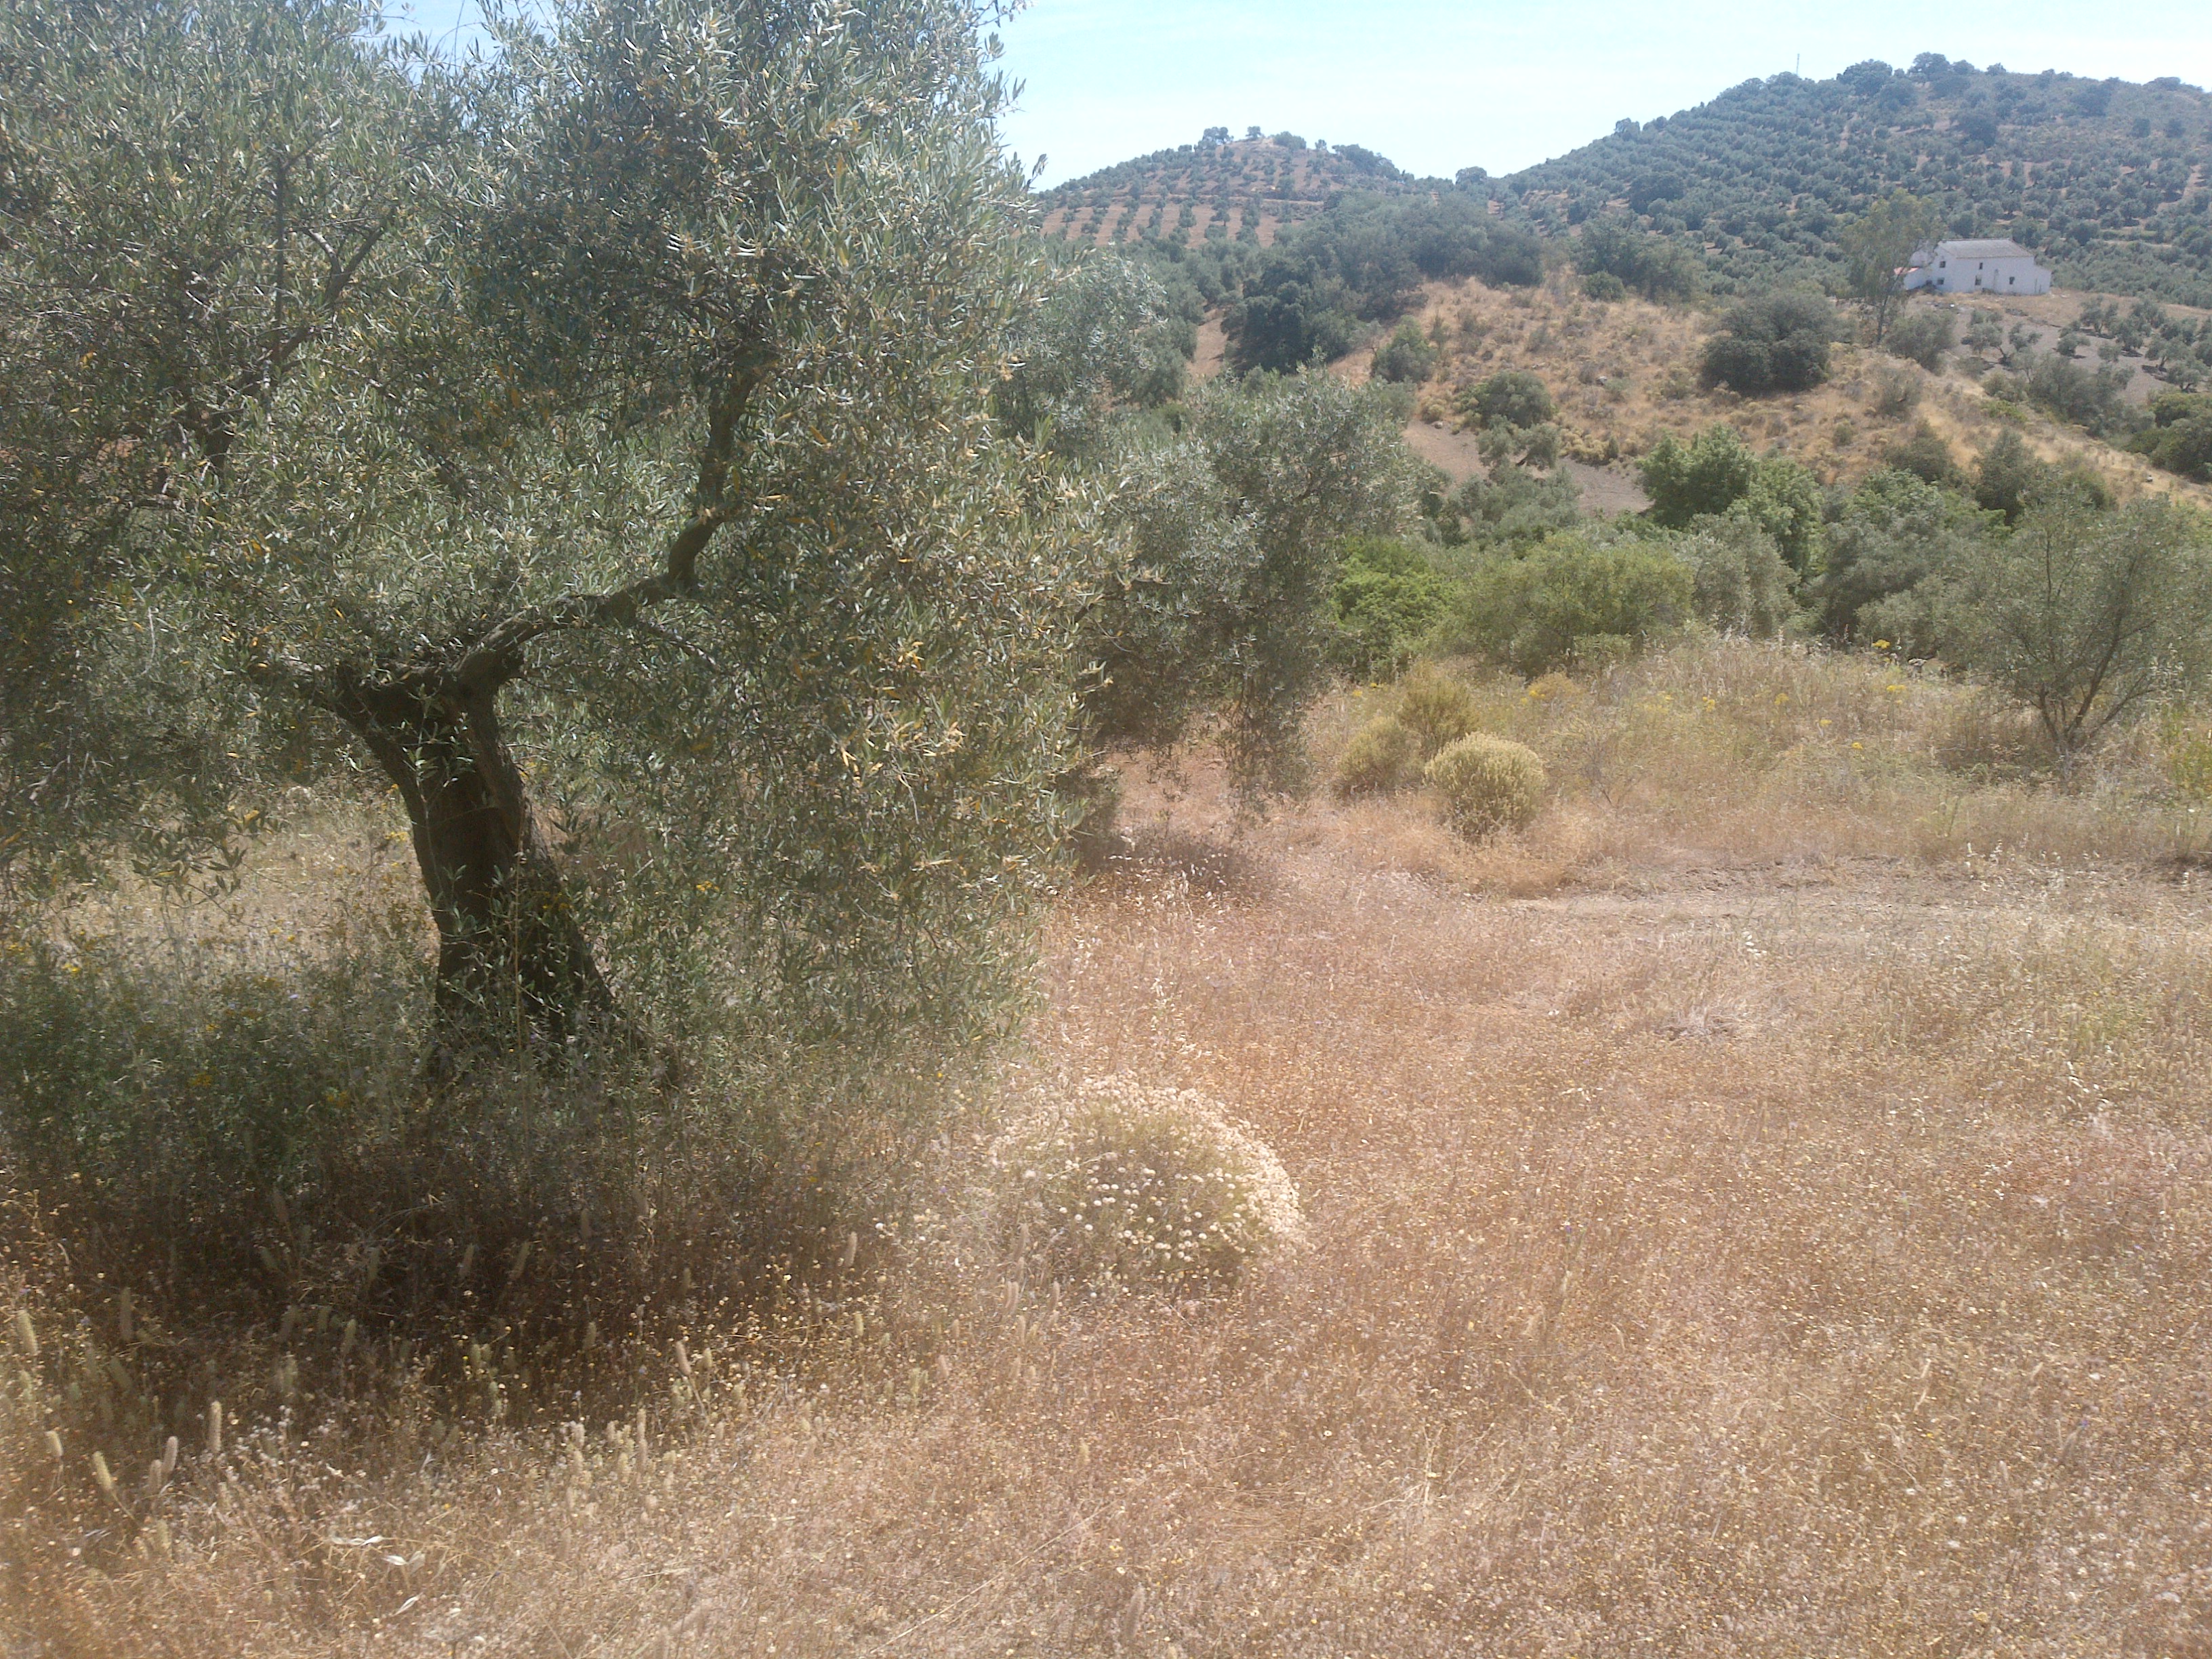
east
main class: Cropland
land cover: Olive groves
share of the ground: 50 - 75 %
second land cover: Spontaneously vegetated surfaces
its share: > 75 %
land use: Agriculture (excluding fallow land and kitchen gardens)
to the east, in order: Olive groves; Spontaneously vegetated surfaces; Tracks; Grassland with sparse tree/shrub cover; Olive groves; Grass margins; Rivers and streams; Grass margins; Olive groves; Shrubland with sparse tree cover; Olive groves
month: May
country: ES
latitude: 38.0459
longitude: -4.4964
